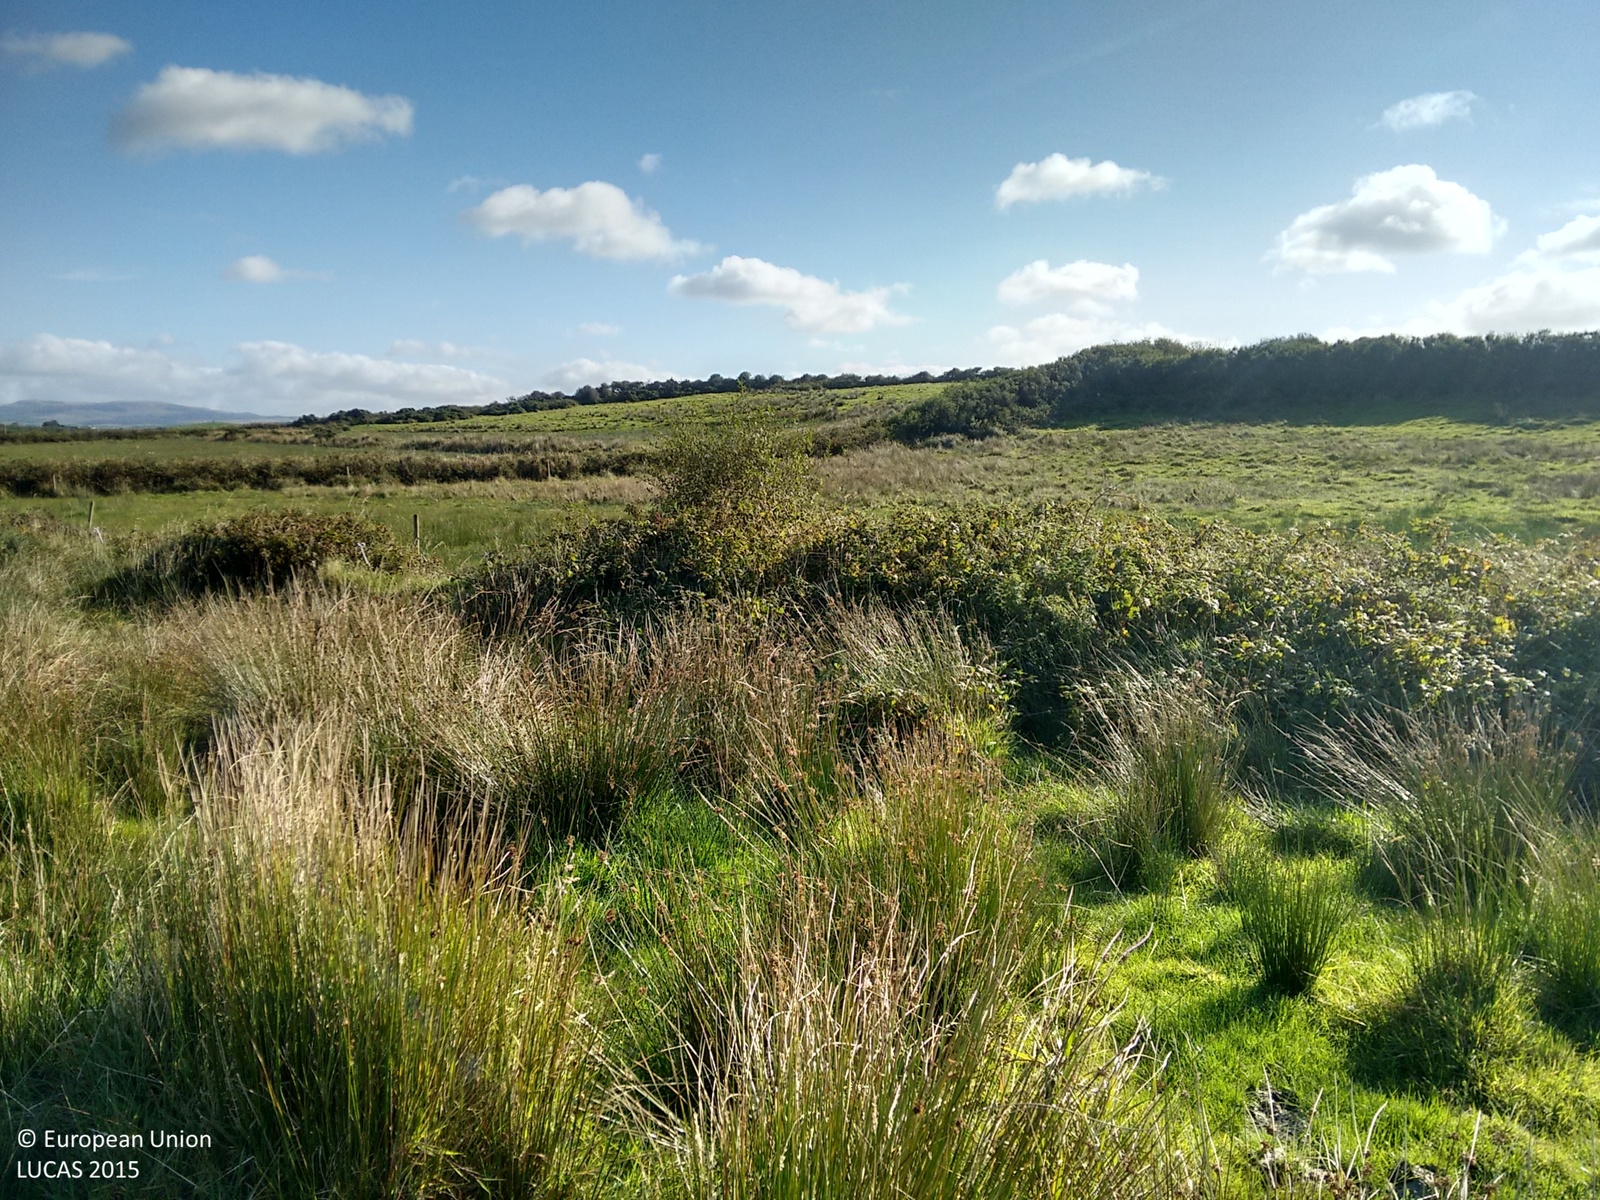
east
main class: Grassland
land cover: Grassland without tree/shrub cover
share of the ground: > 75 %
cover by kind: herbaceous plants 100 %
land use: Agriculture (excluding fallow land and kitchen gardens)
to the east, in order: Grassland without tree/shrub cover; Abandoned hedges; Ditches and canals; Fences; Grassland without tree/shrub cover; Fences; Ditches and canals; Abandoned hedges; Grassland without tree/shrub cover; Abandoned hedges; Grassland without tree/shrub cover
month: September
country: IE
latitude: 52.7913
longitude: -9.4031
